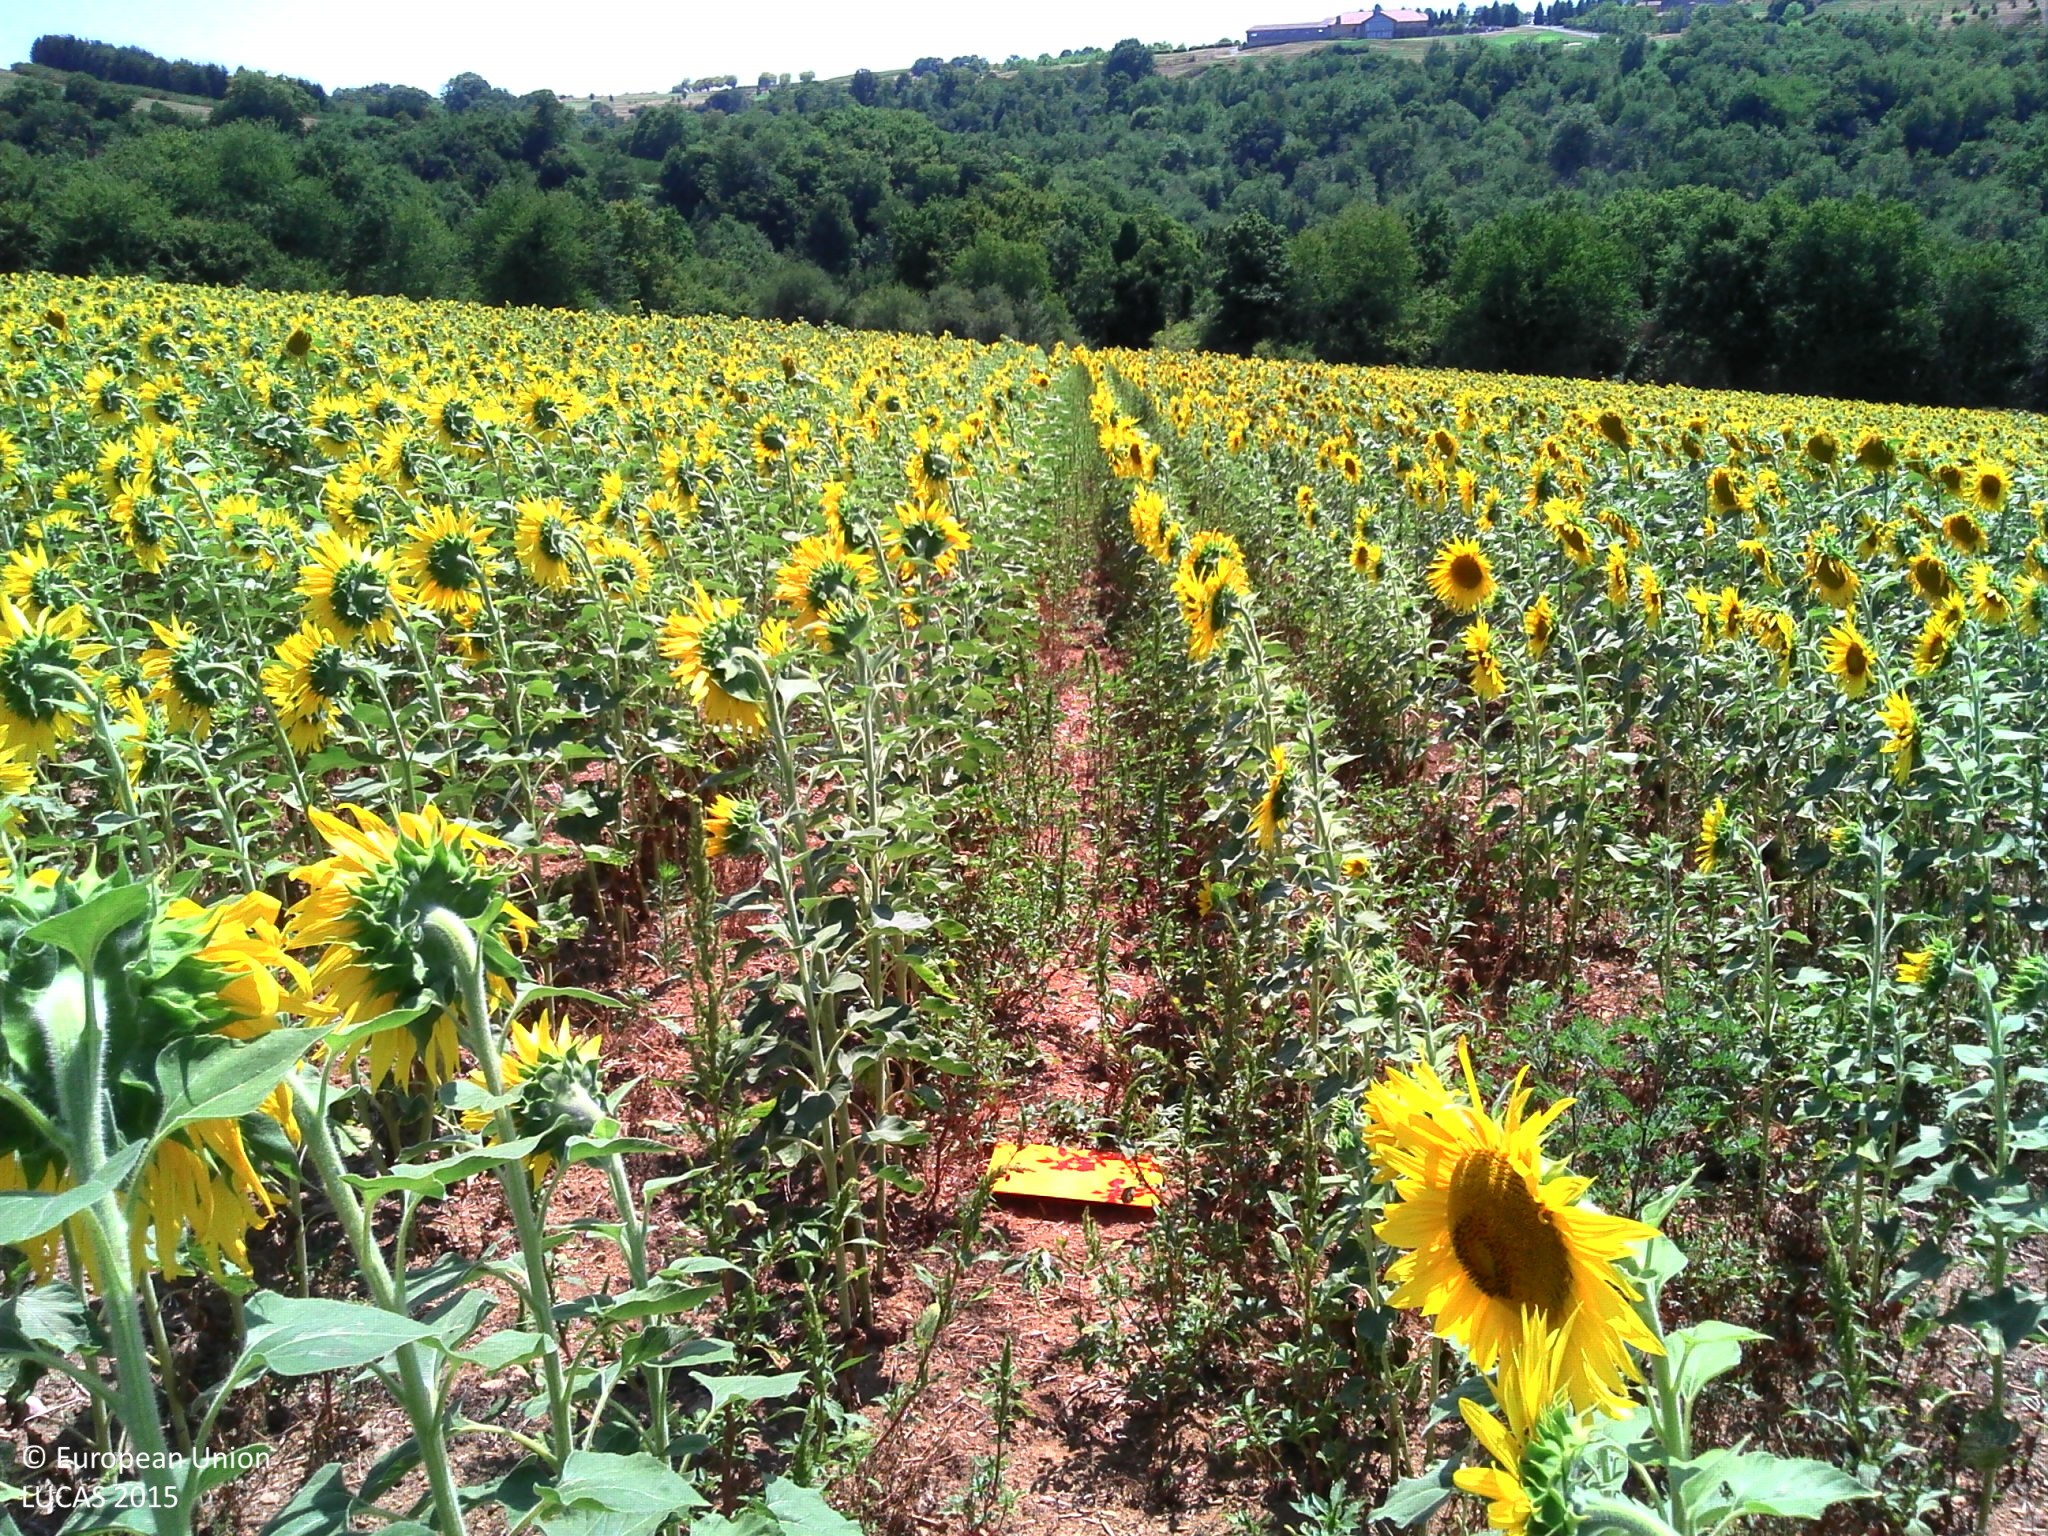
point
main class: Cropland
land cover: Sunflower
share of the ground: 50 - 75 %
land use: Agriculture (excluding fallow land and kitchen gardens)
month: August
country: FR
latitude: 45.3630
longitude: 1.0934
